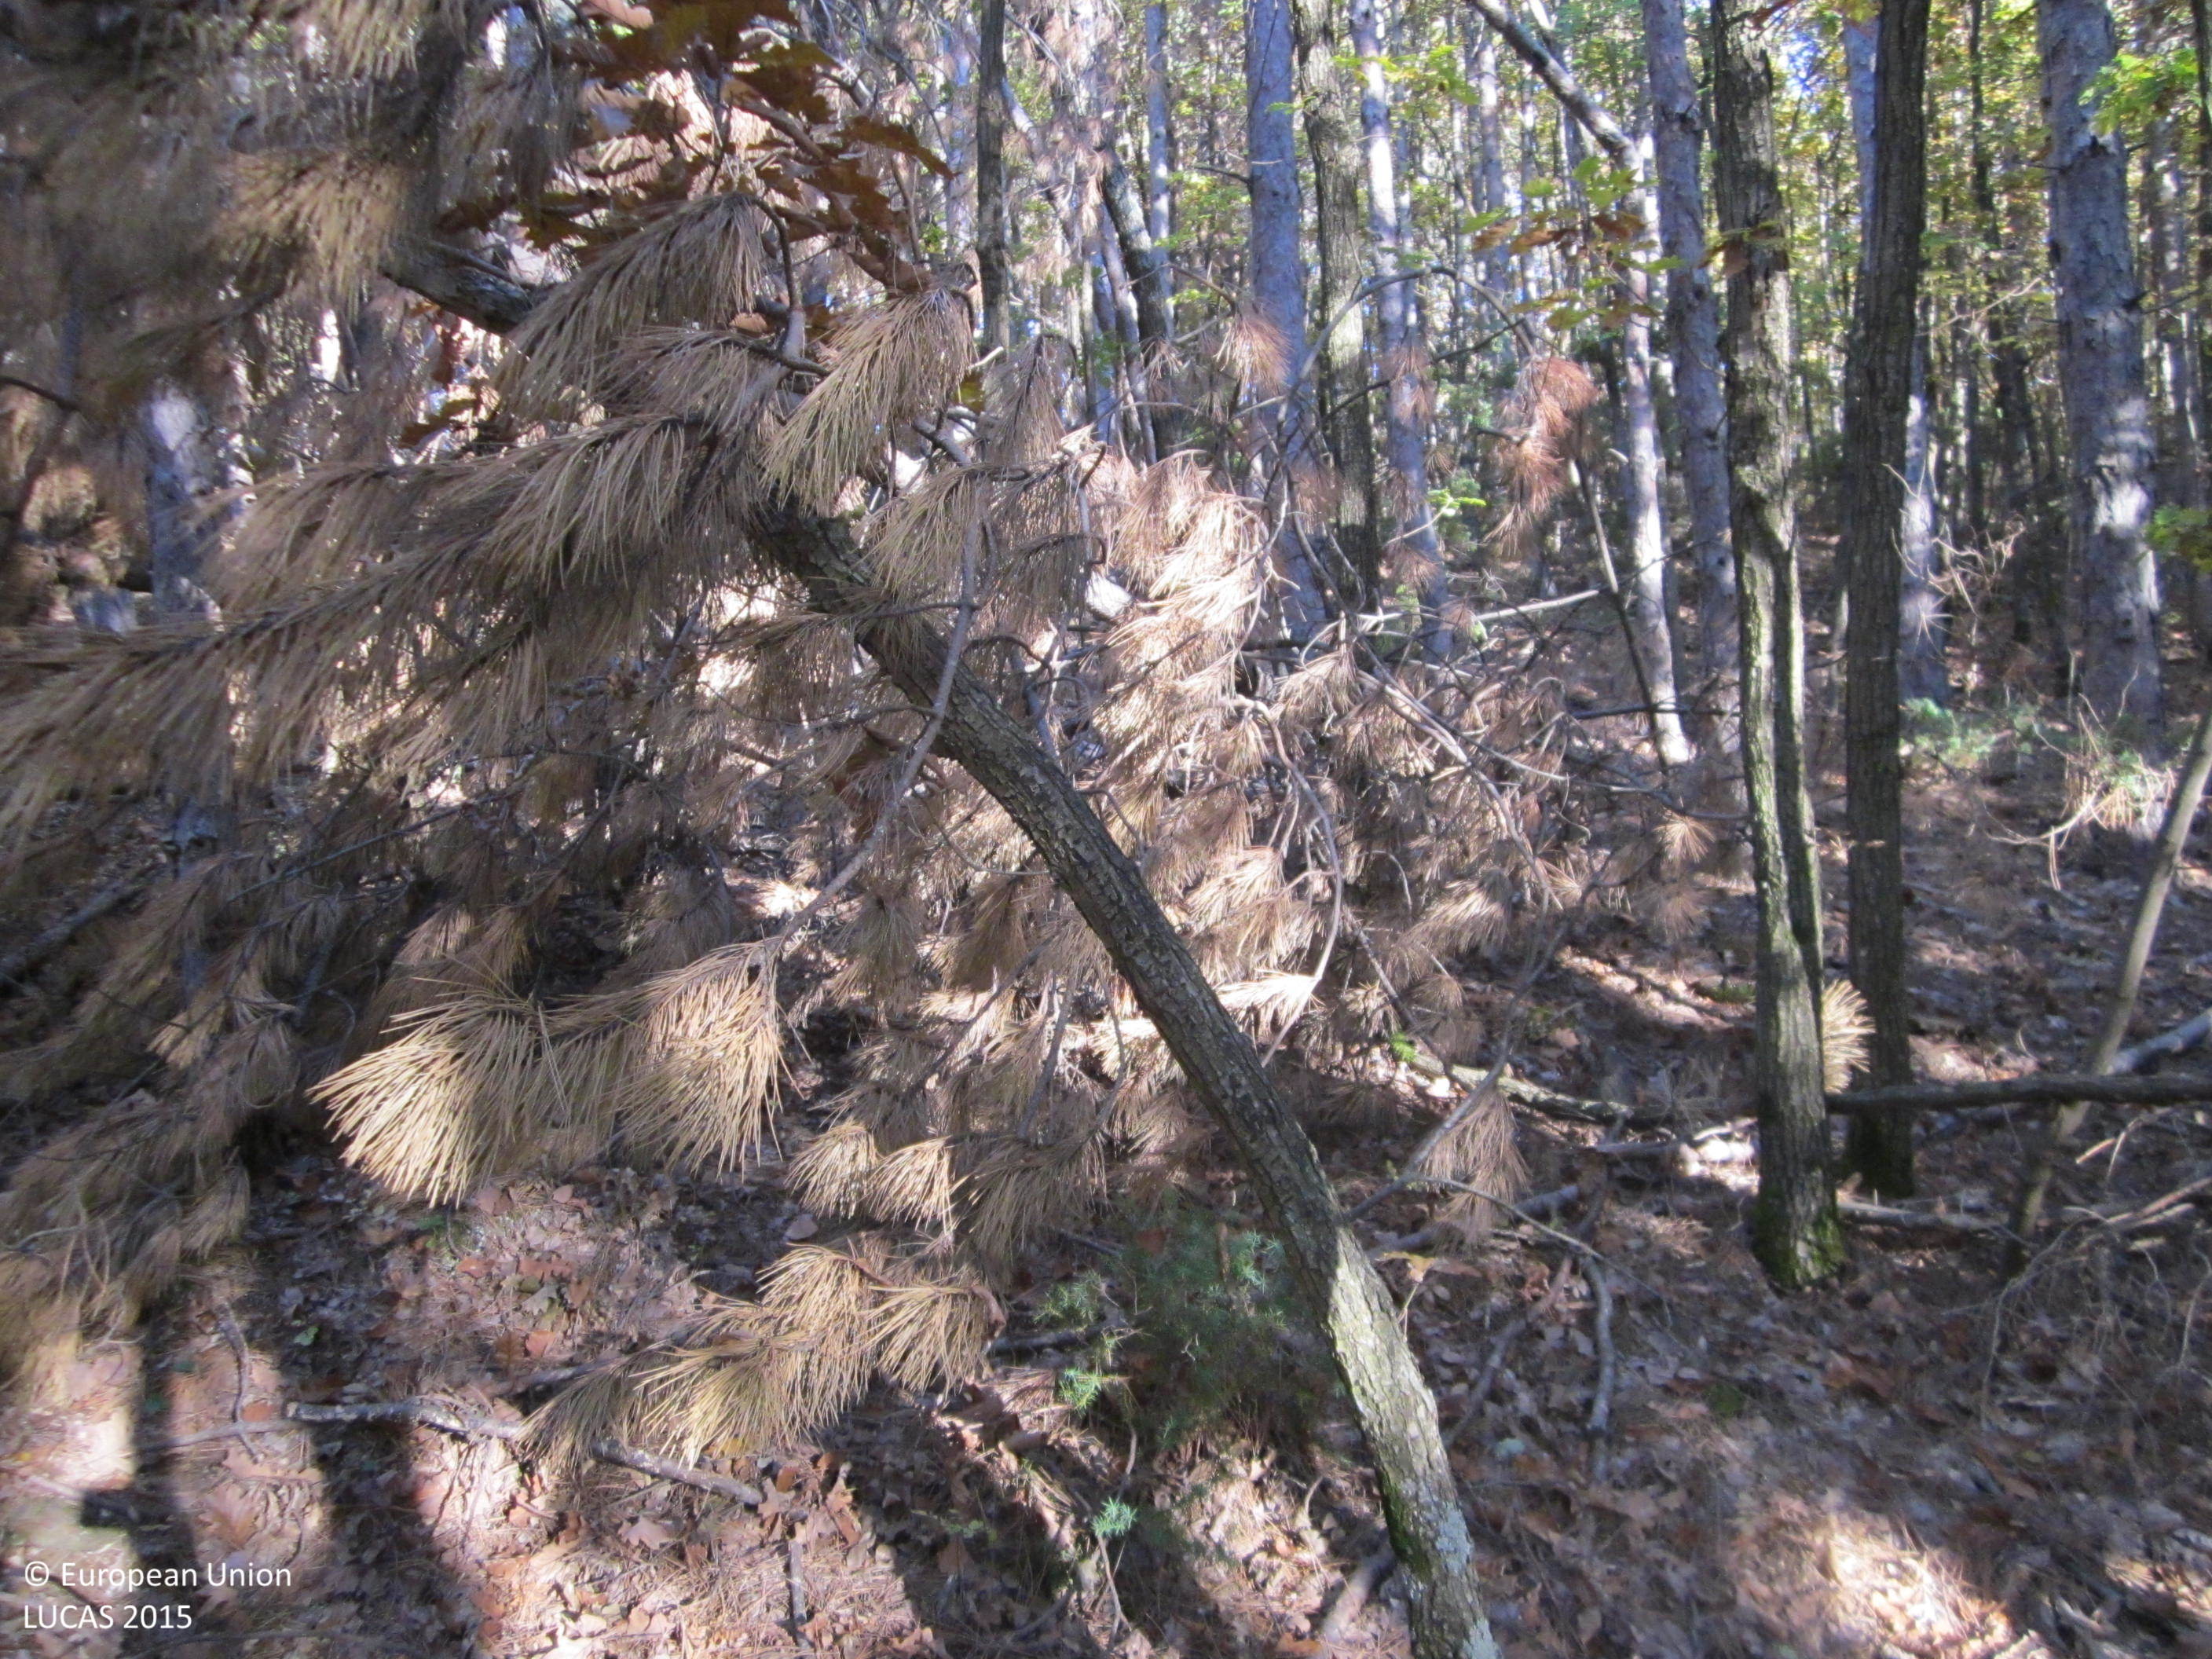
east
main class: Woodland
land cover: Pine dominated mixed woodland
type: hemiboreal forest and nemoral coniferous forest and mixed broadleaved-coniferous forest
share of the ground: > 75 %
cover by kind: coniferous forest trees 60 %, broadleaved forest trees 20 %, unconsolidated bare surface 15 %, lichens and mosses 5 %
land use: Forestry
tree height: > 5 m
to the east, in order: Pine dominated mixed woodland; Pine dominated coniferous woodland; Tracks; Broadleaved woodland; Pine dominated mixed woodland
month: November
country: BG
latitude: 41.5621
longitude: 25.7352
